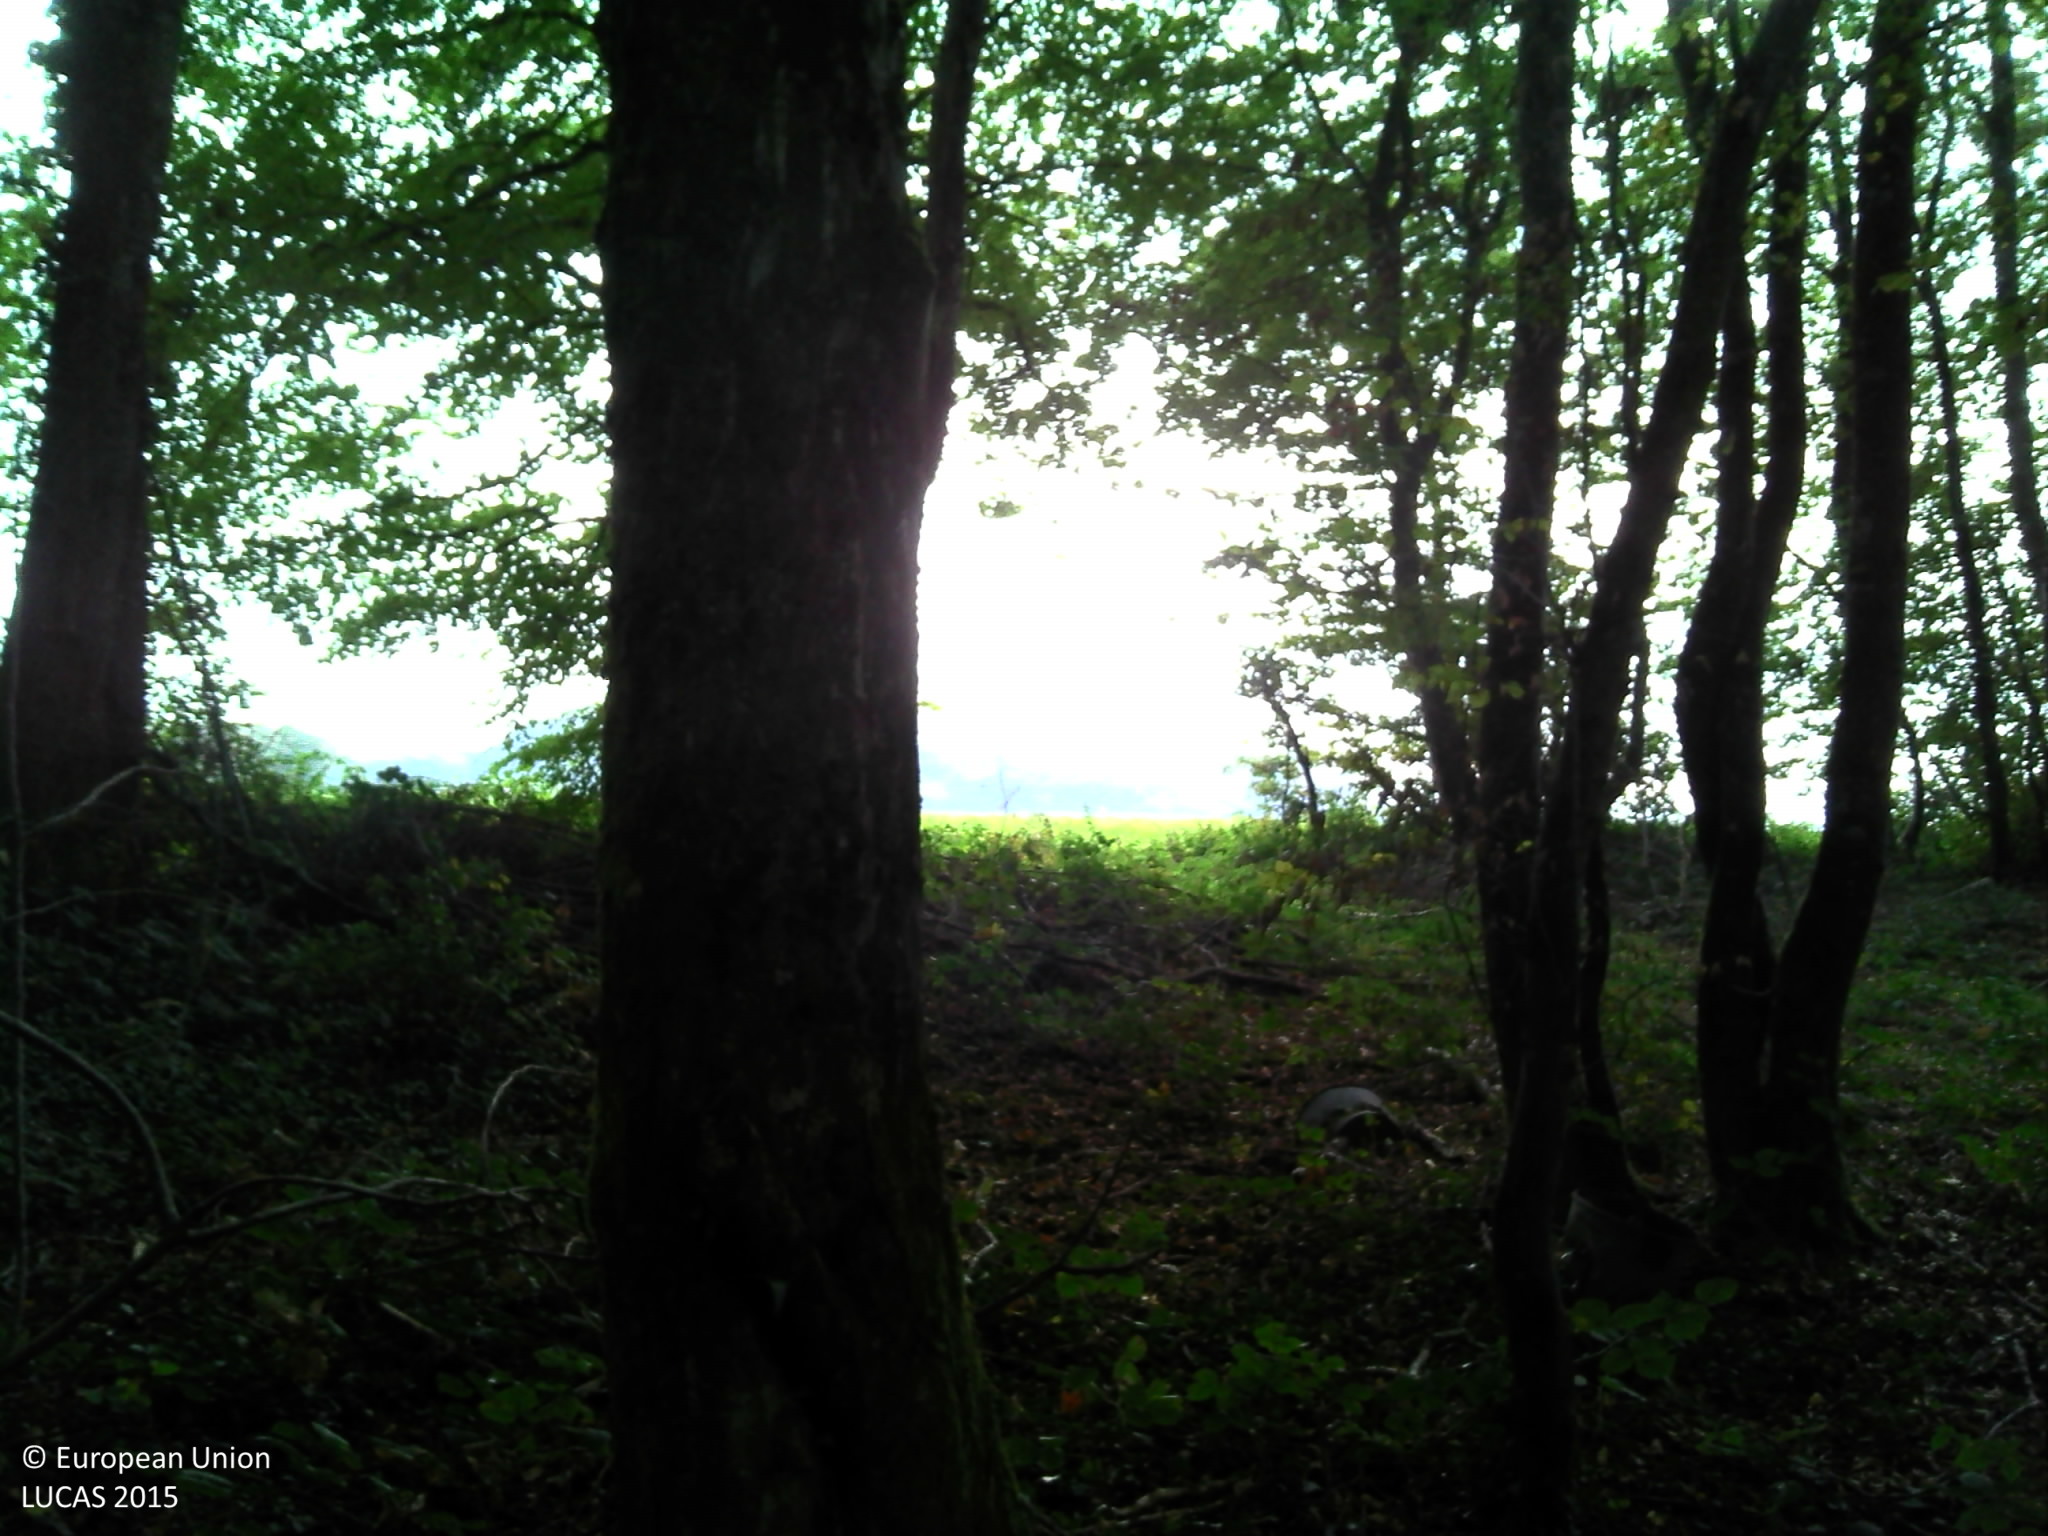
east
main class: Woodland
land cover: Broadleaved woodland
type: mesophytic deciduous forest
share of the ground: > 75 %
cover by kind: broadleaved forest trees 90 %, herbaceous plants 10 %
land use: Forestry
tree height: > 5 m
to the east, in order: Broadleaved woodland; Grass margins; Maize; Grass margins; Paved roads, cycling and walking lanes; Grass margins; Maize; Grass margins; Ditches and canals; Grass margins; Maize
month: October
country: FR
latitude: 46.0859
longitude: 5.3088
